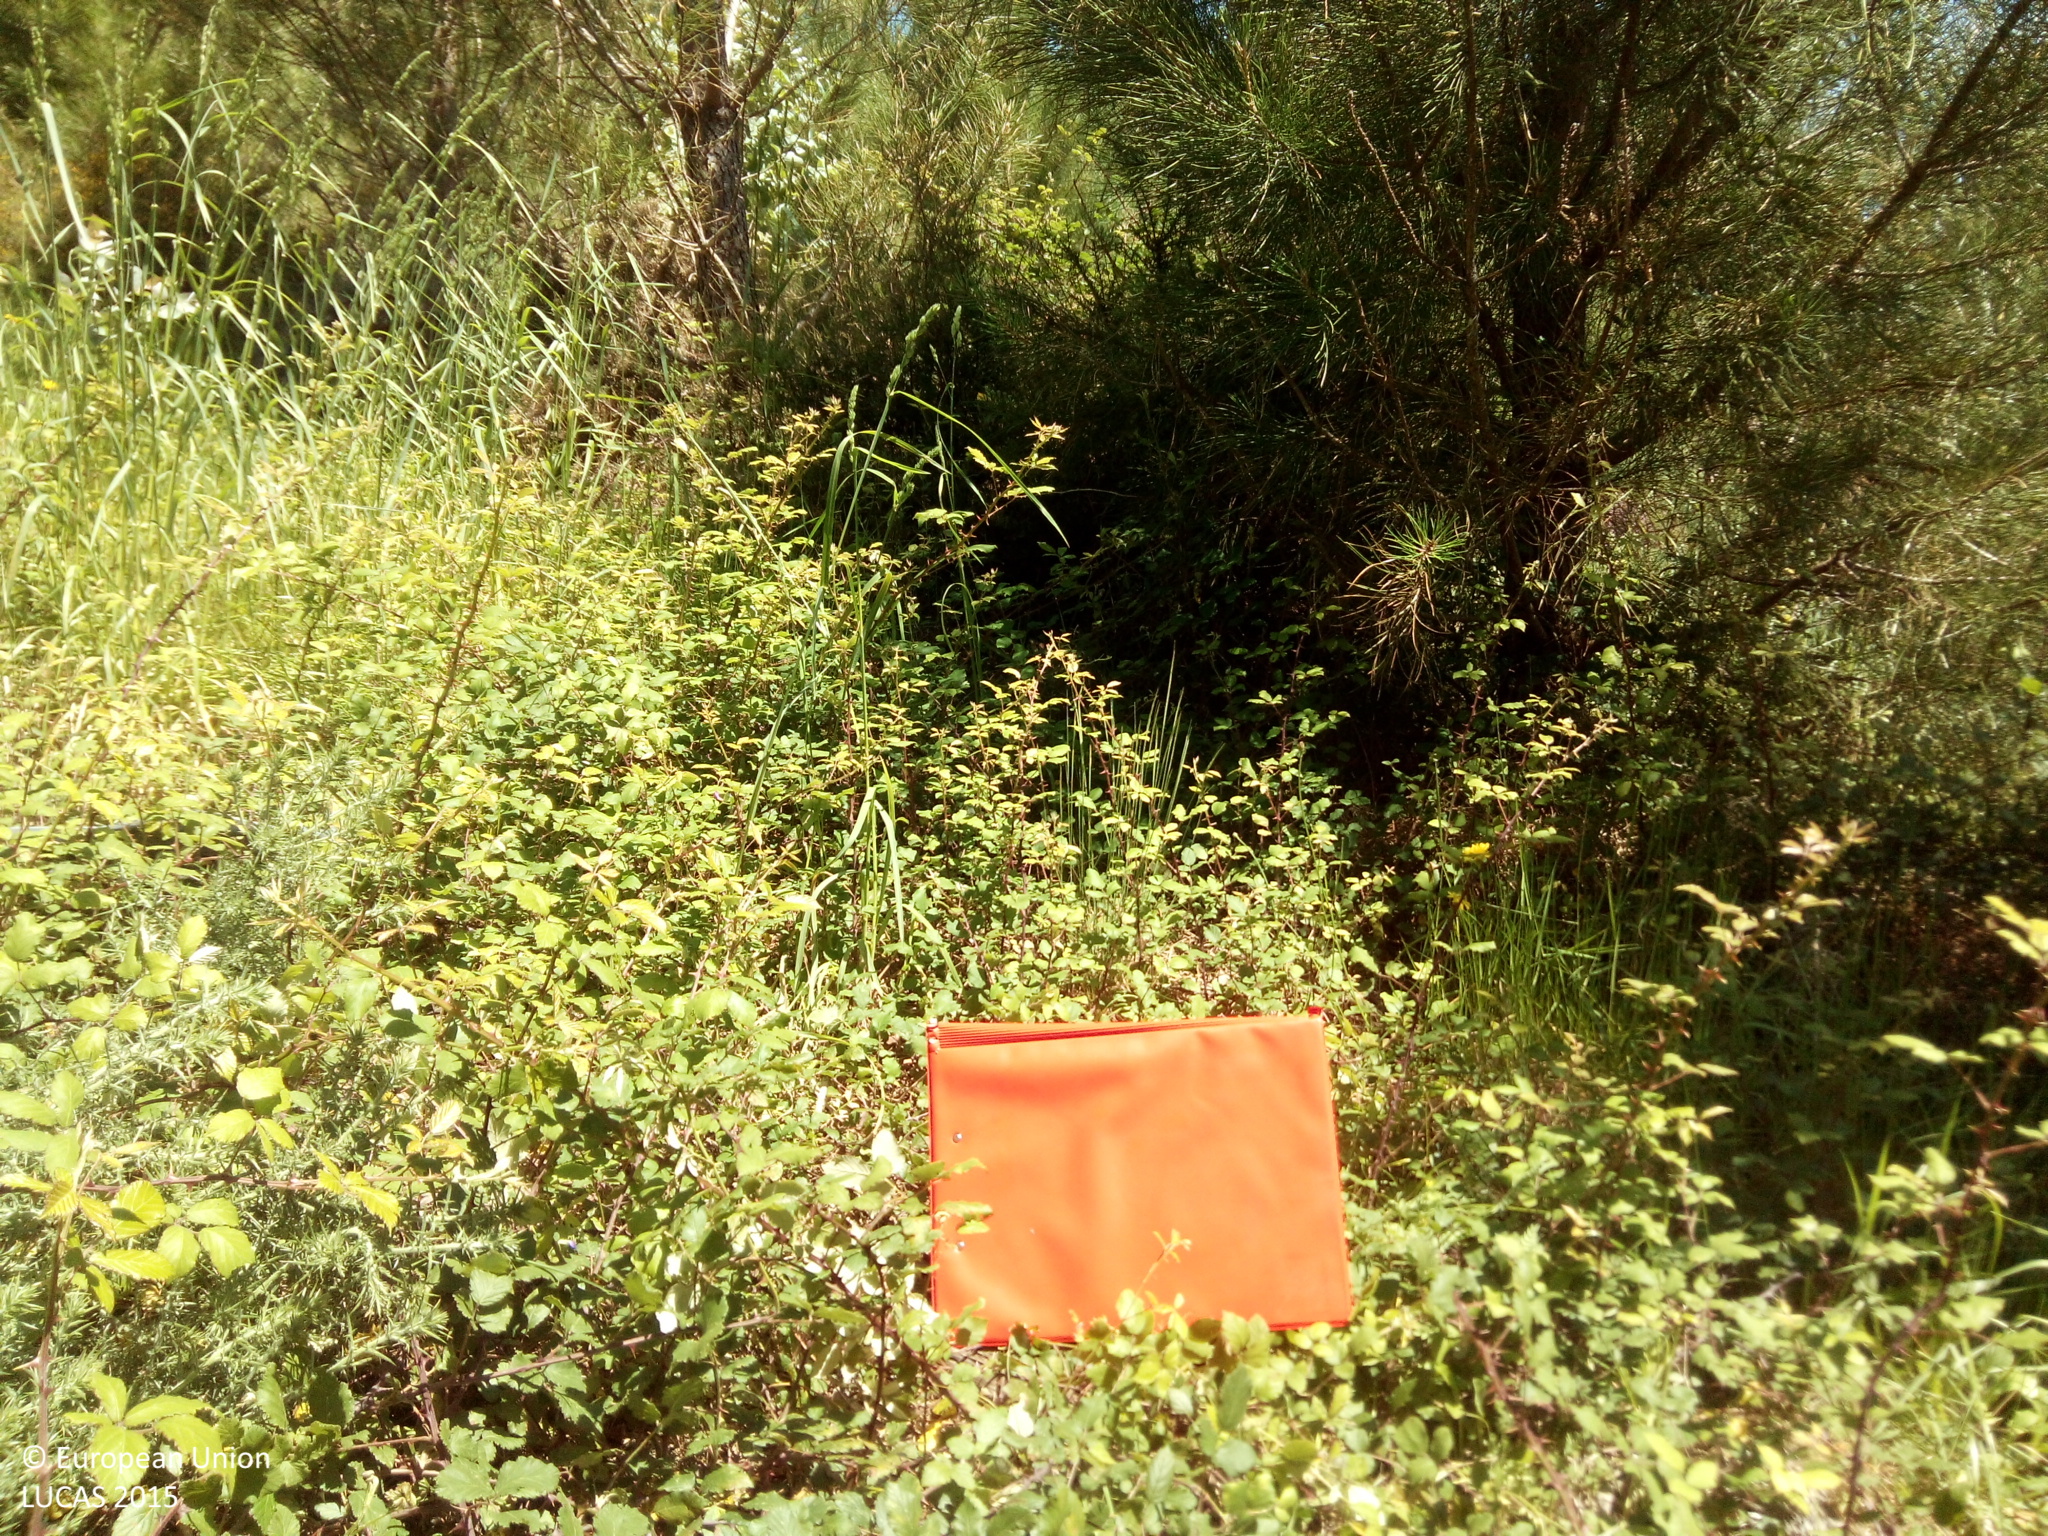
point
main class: Woodland
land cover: Pine dominated coniferous woodland
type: exotic forest
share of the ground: > 75 %
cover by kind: coniferous forest trees 70 %, shrubs 20 %, herbaceous plants 10 %
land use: Forestry
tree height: > 5 m
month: May
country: ES
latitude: 42.6470
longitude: -9.0099
